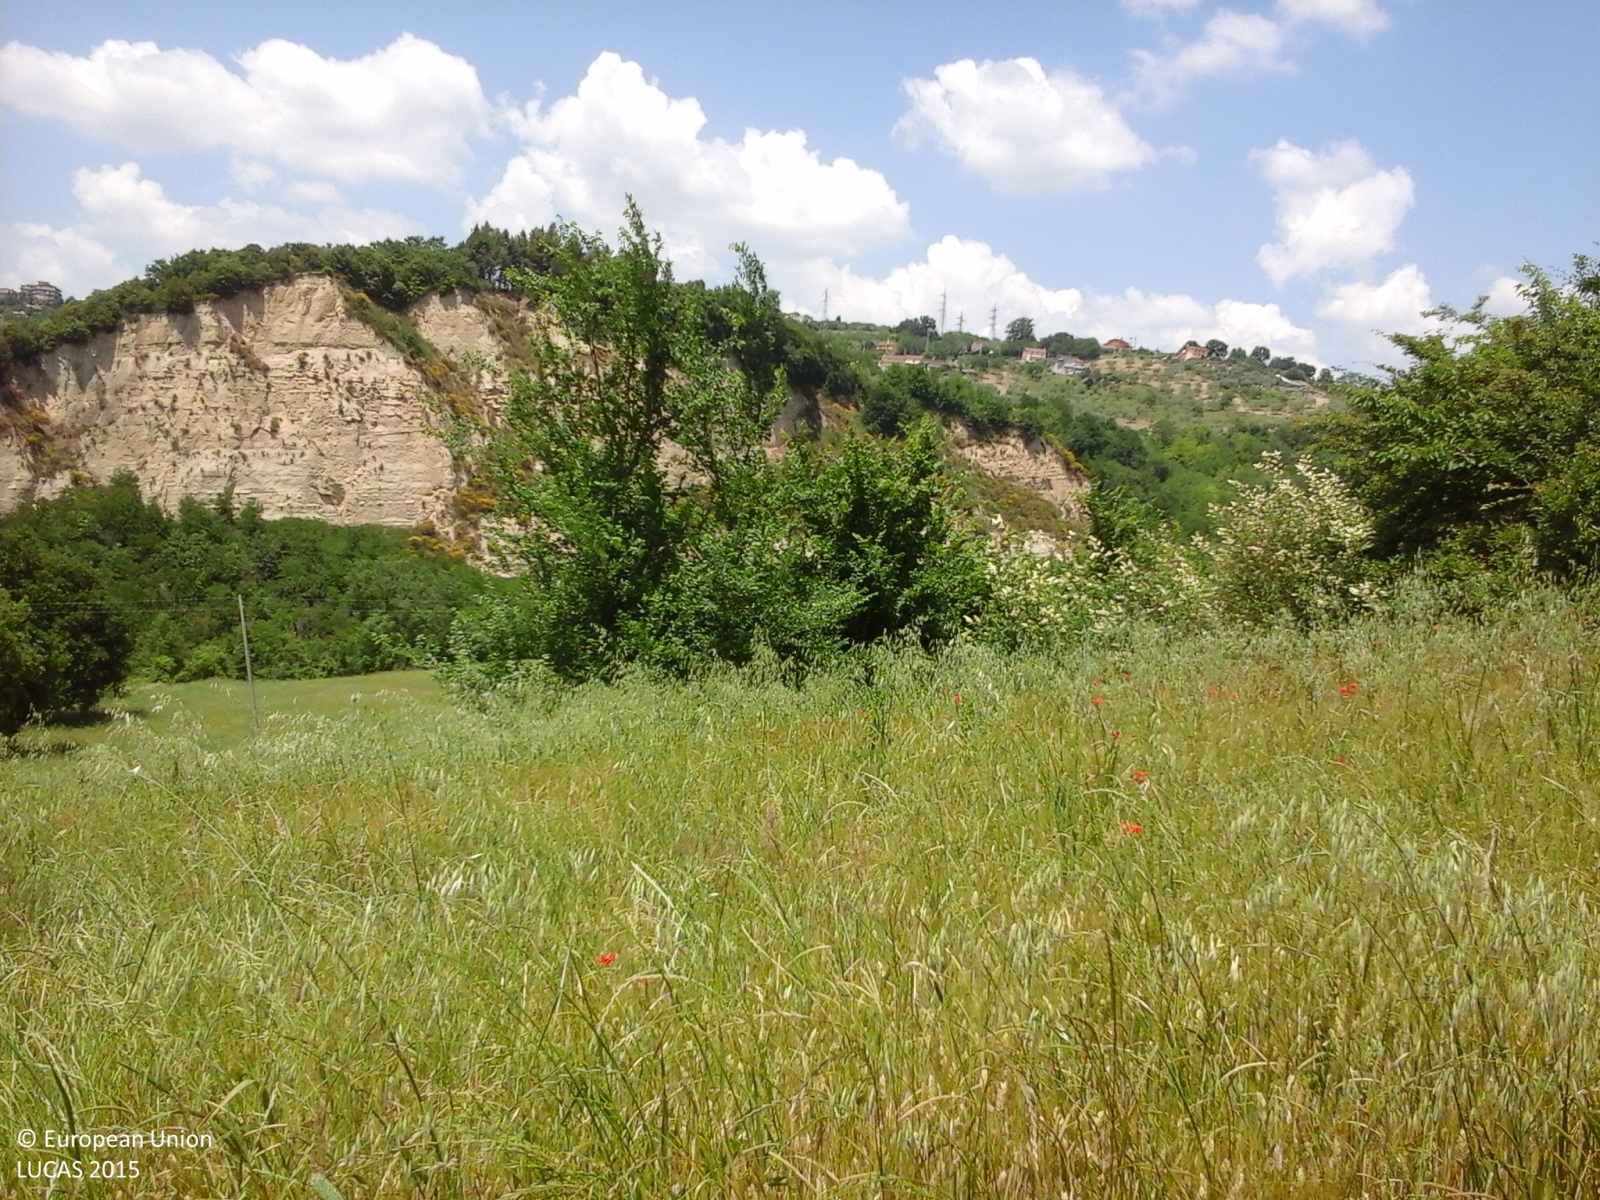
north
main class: Cropland
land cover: Mixed cereals for fodder
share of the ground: > 75 %
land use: Agriculture (excluding fallow land and kitchen gardens)
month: June
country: IT
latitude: 41.1488
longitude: 15.1167
